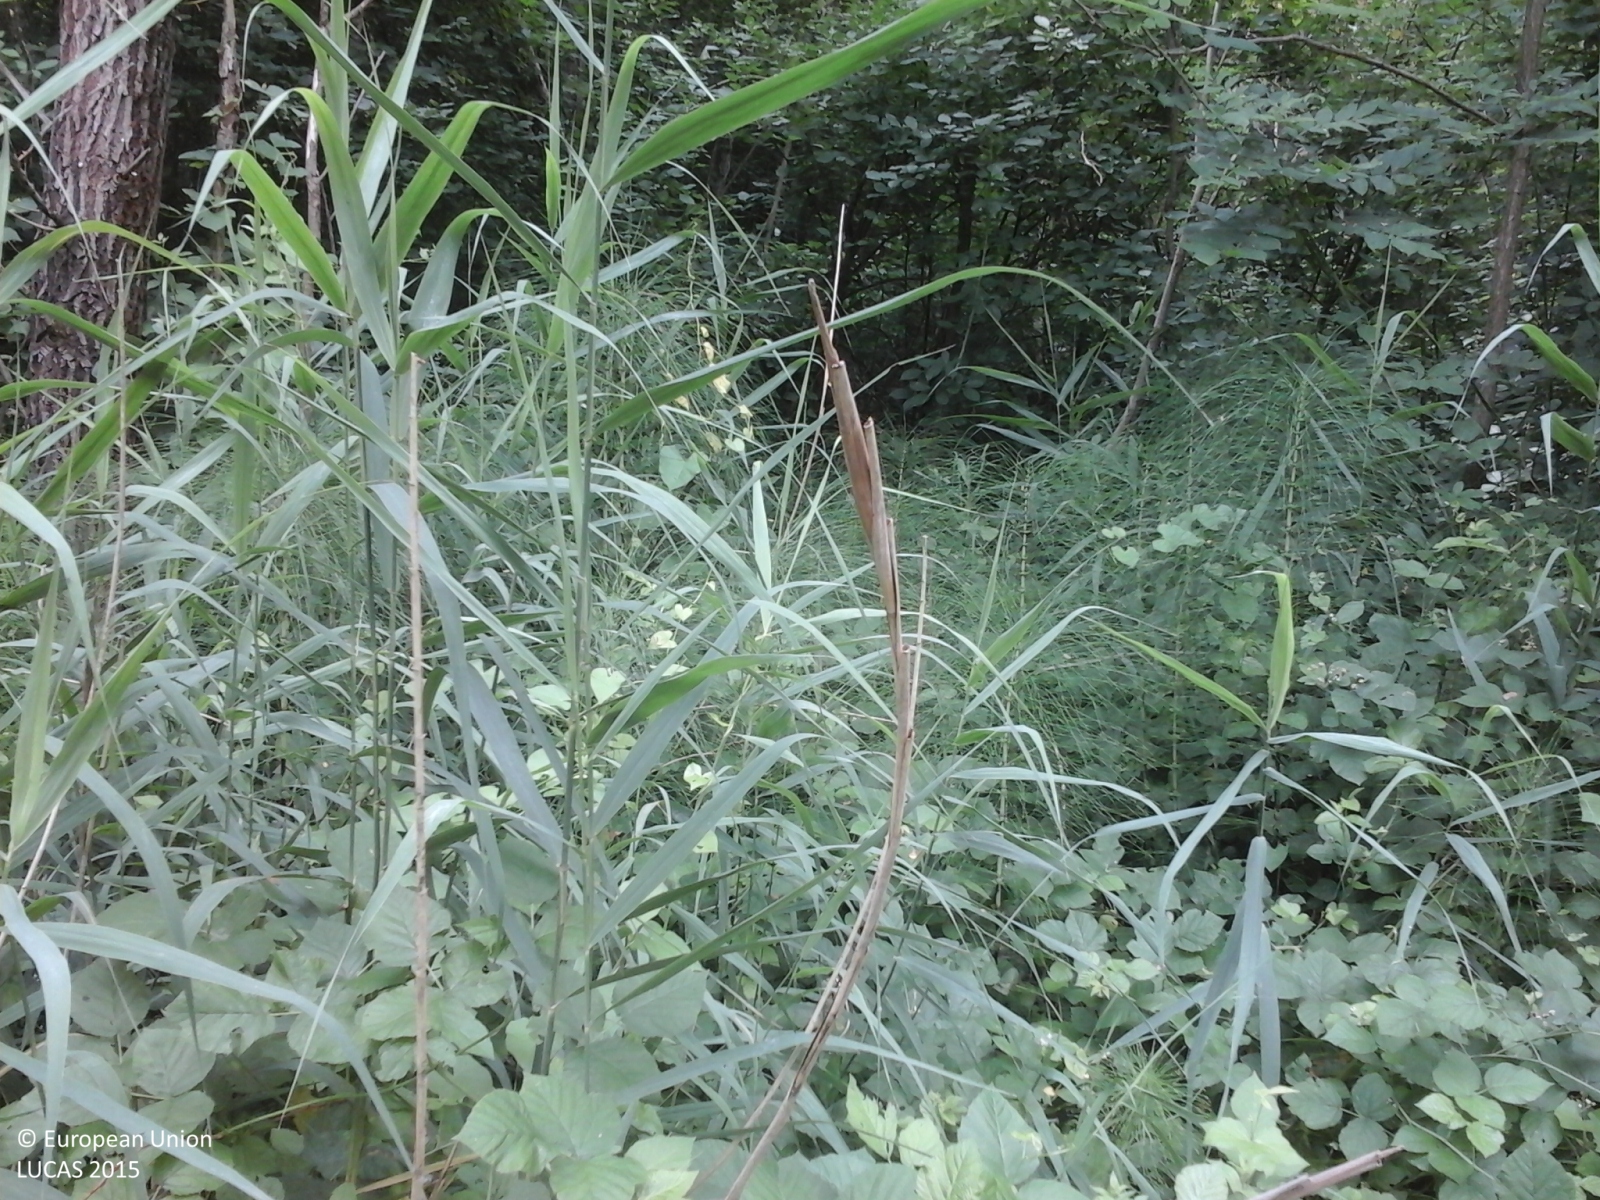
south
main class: Woodland
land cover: Broadleaved woodland
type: thermophilous deciduous forest
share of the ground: > 75 %
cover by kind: broadleaved forest trees 100 %
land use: Semi-natural and natural areas not in use
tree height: > 5 m
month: July
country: IT
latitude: 45.1245
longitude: 7.1949
